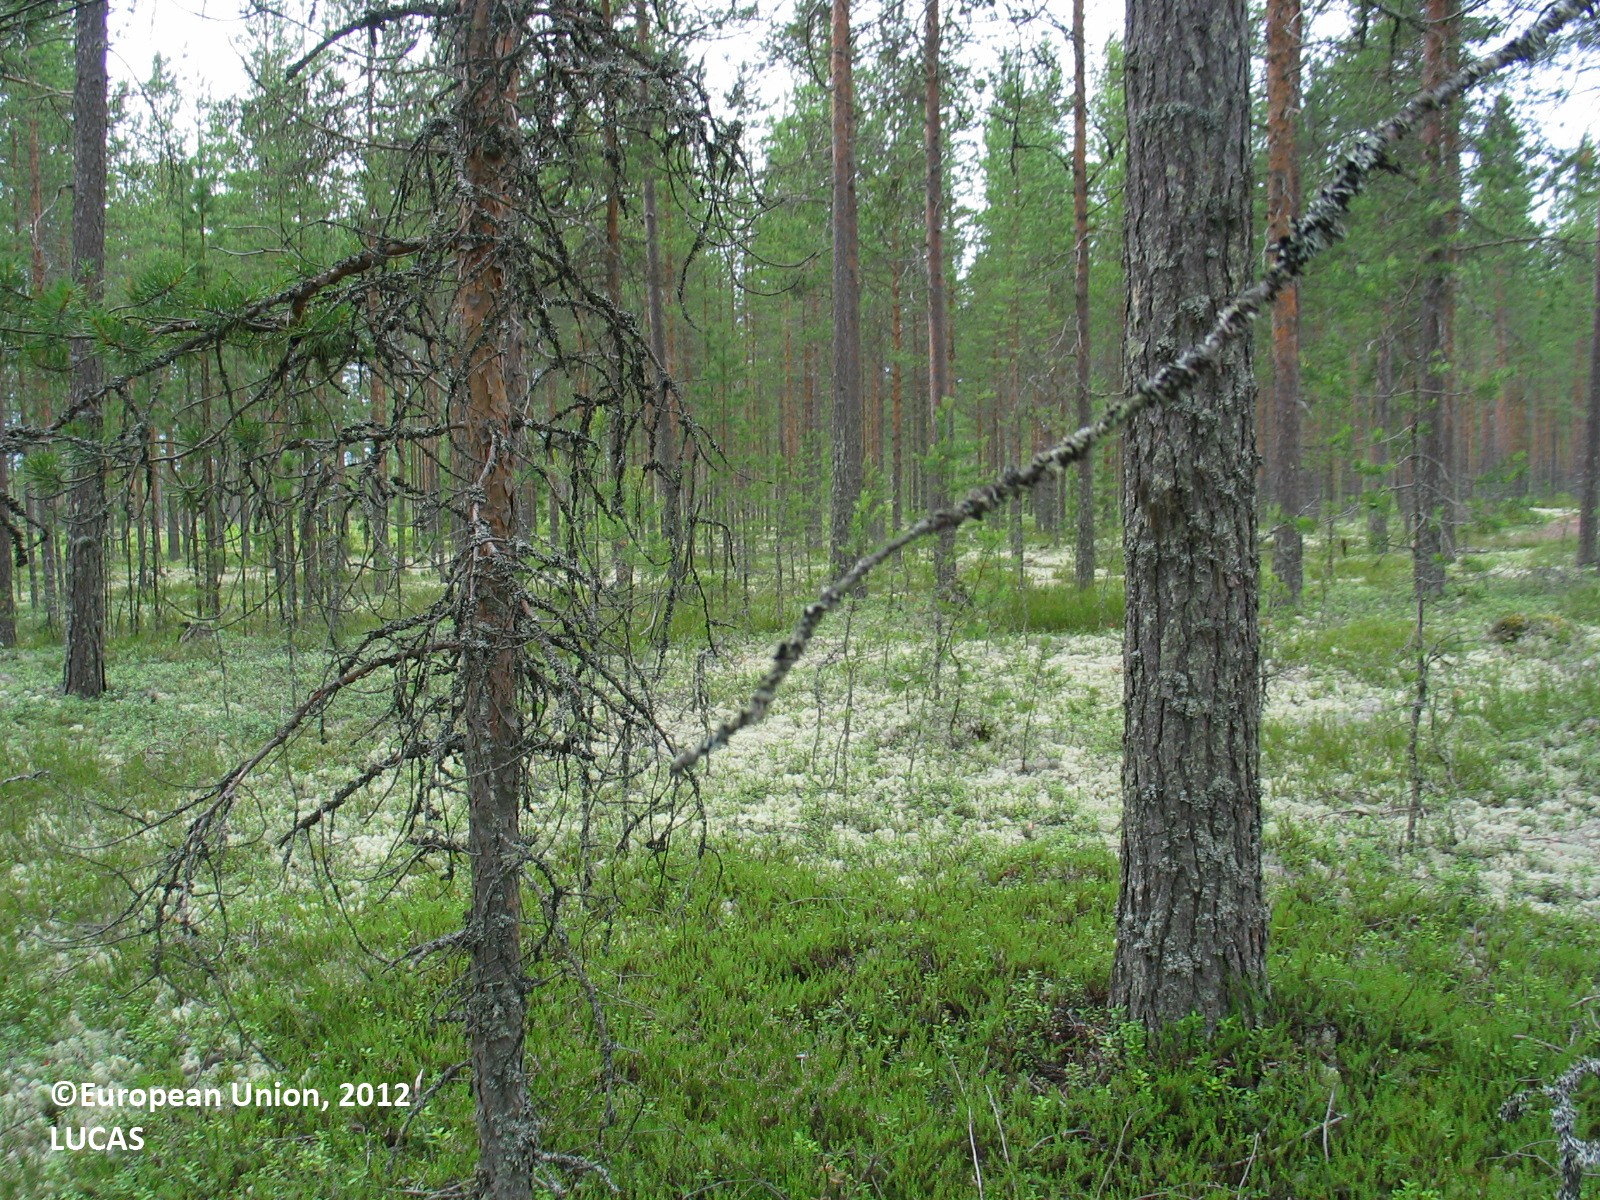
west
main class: Woodland
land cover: Pine dominated coniferous woodland
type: boreal forest
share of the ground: 50 - 75 %
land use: Forestry
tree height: > 5 m
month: July
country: FI
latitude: 64.6336
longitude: 26.3646
